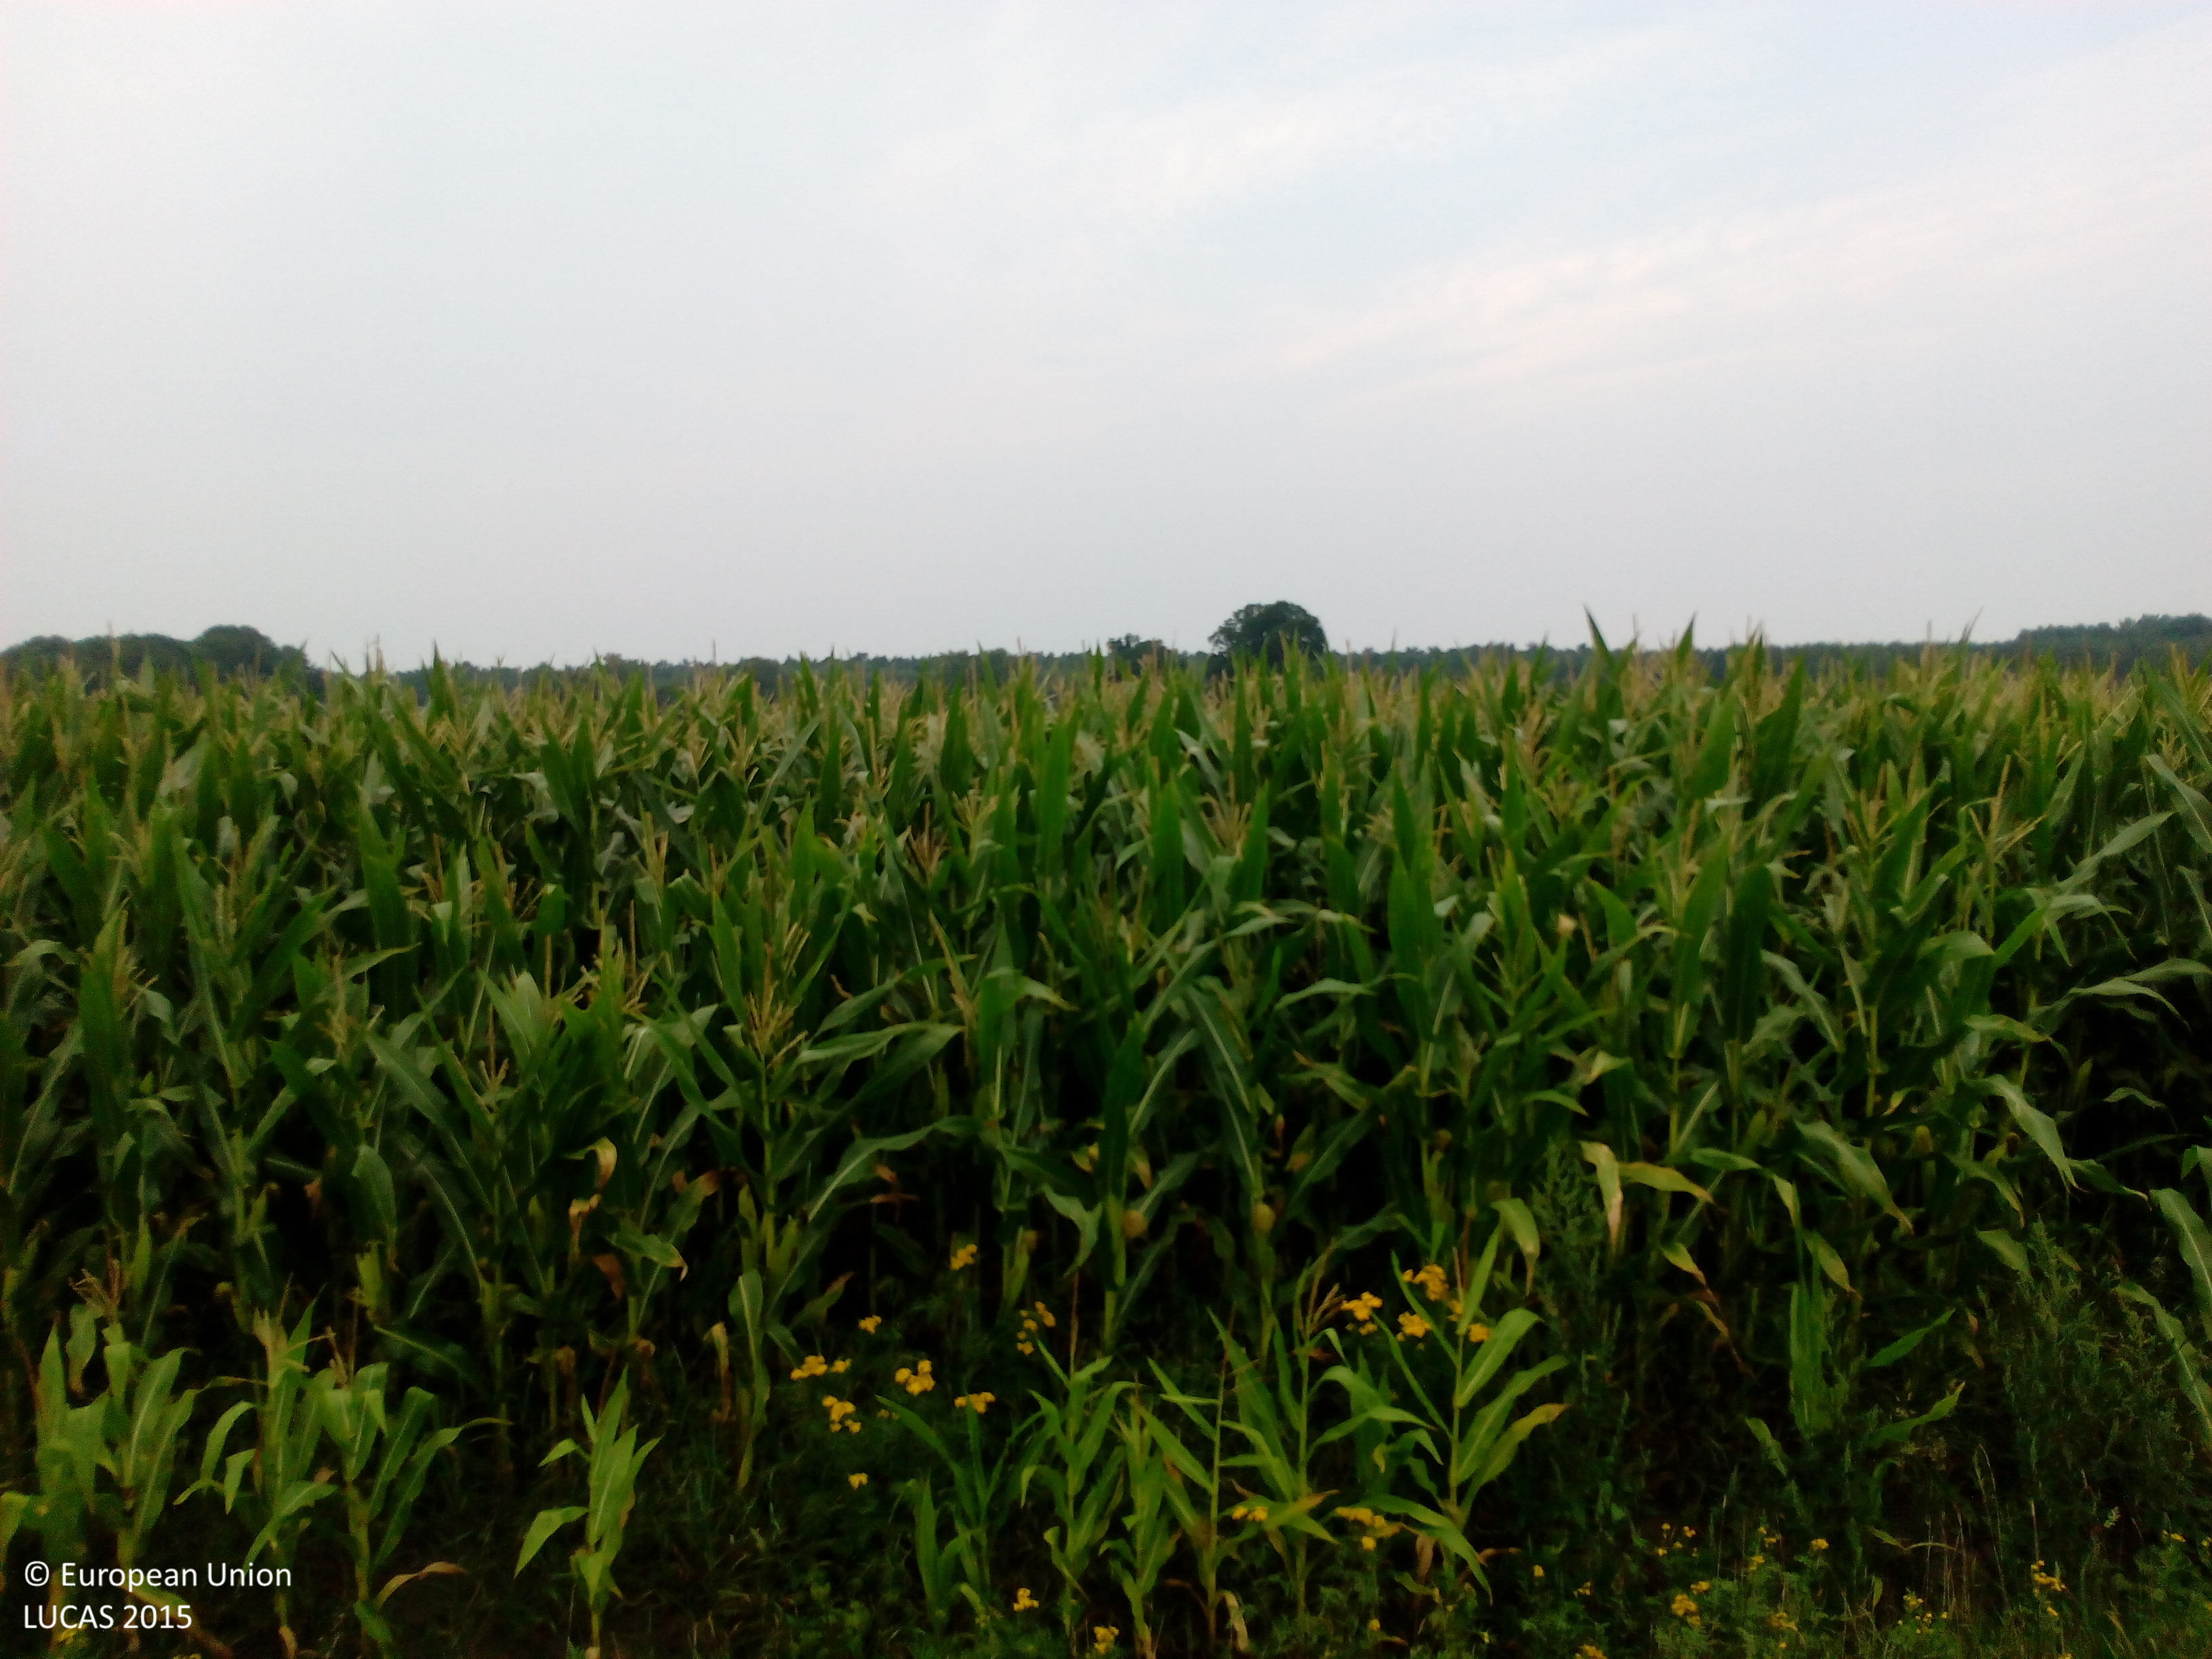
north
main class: Cropland
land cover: Maize
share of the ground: > 75 %
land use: Agriculture (excluding fallow land and kitchen gardens)
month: August
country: DE
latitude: 52.6737
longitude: 8.5068
